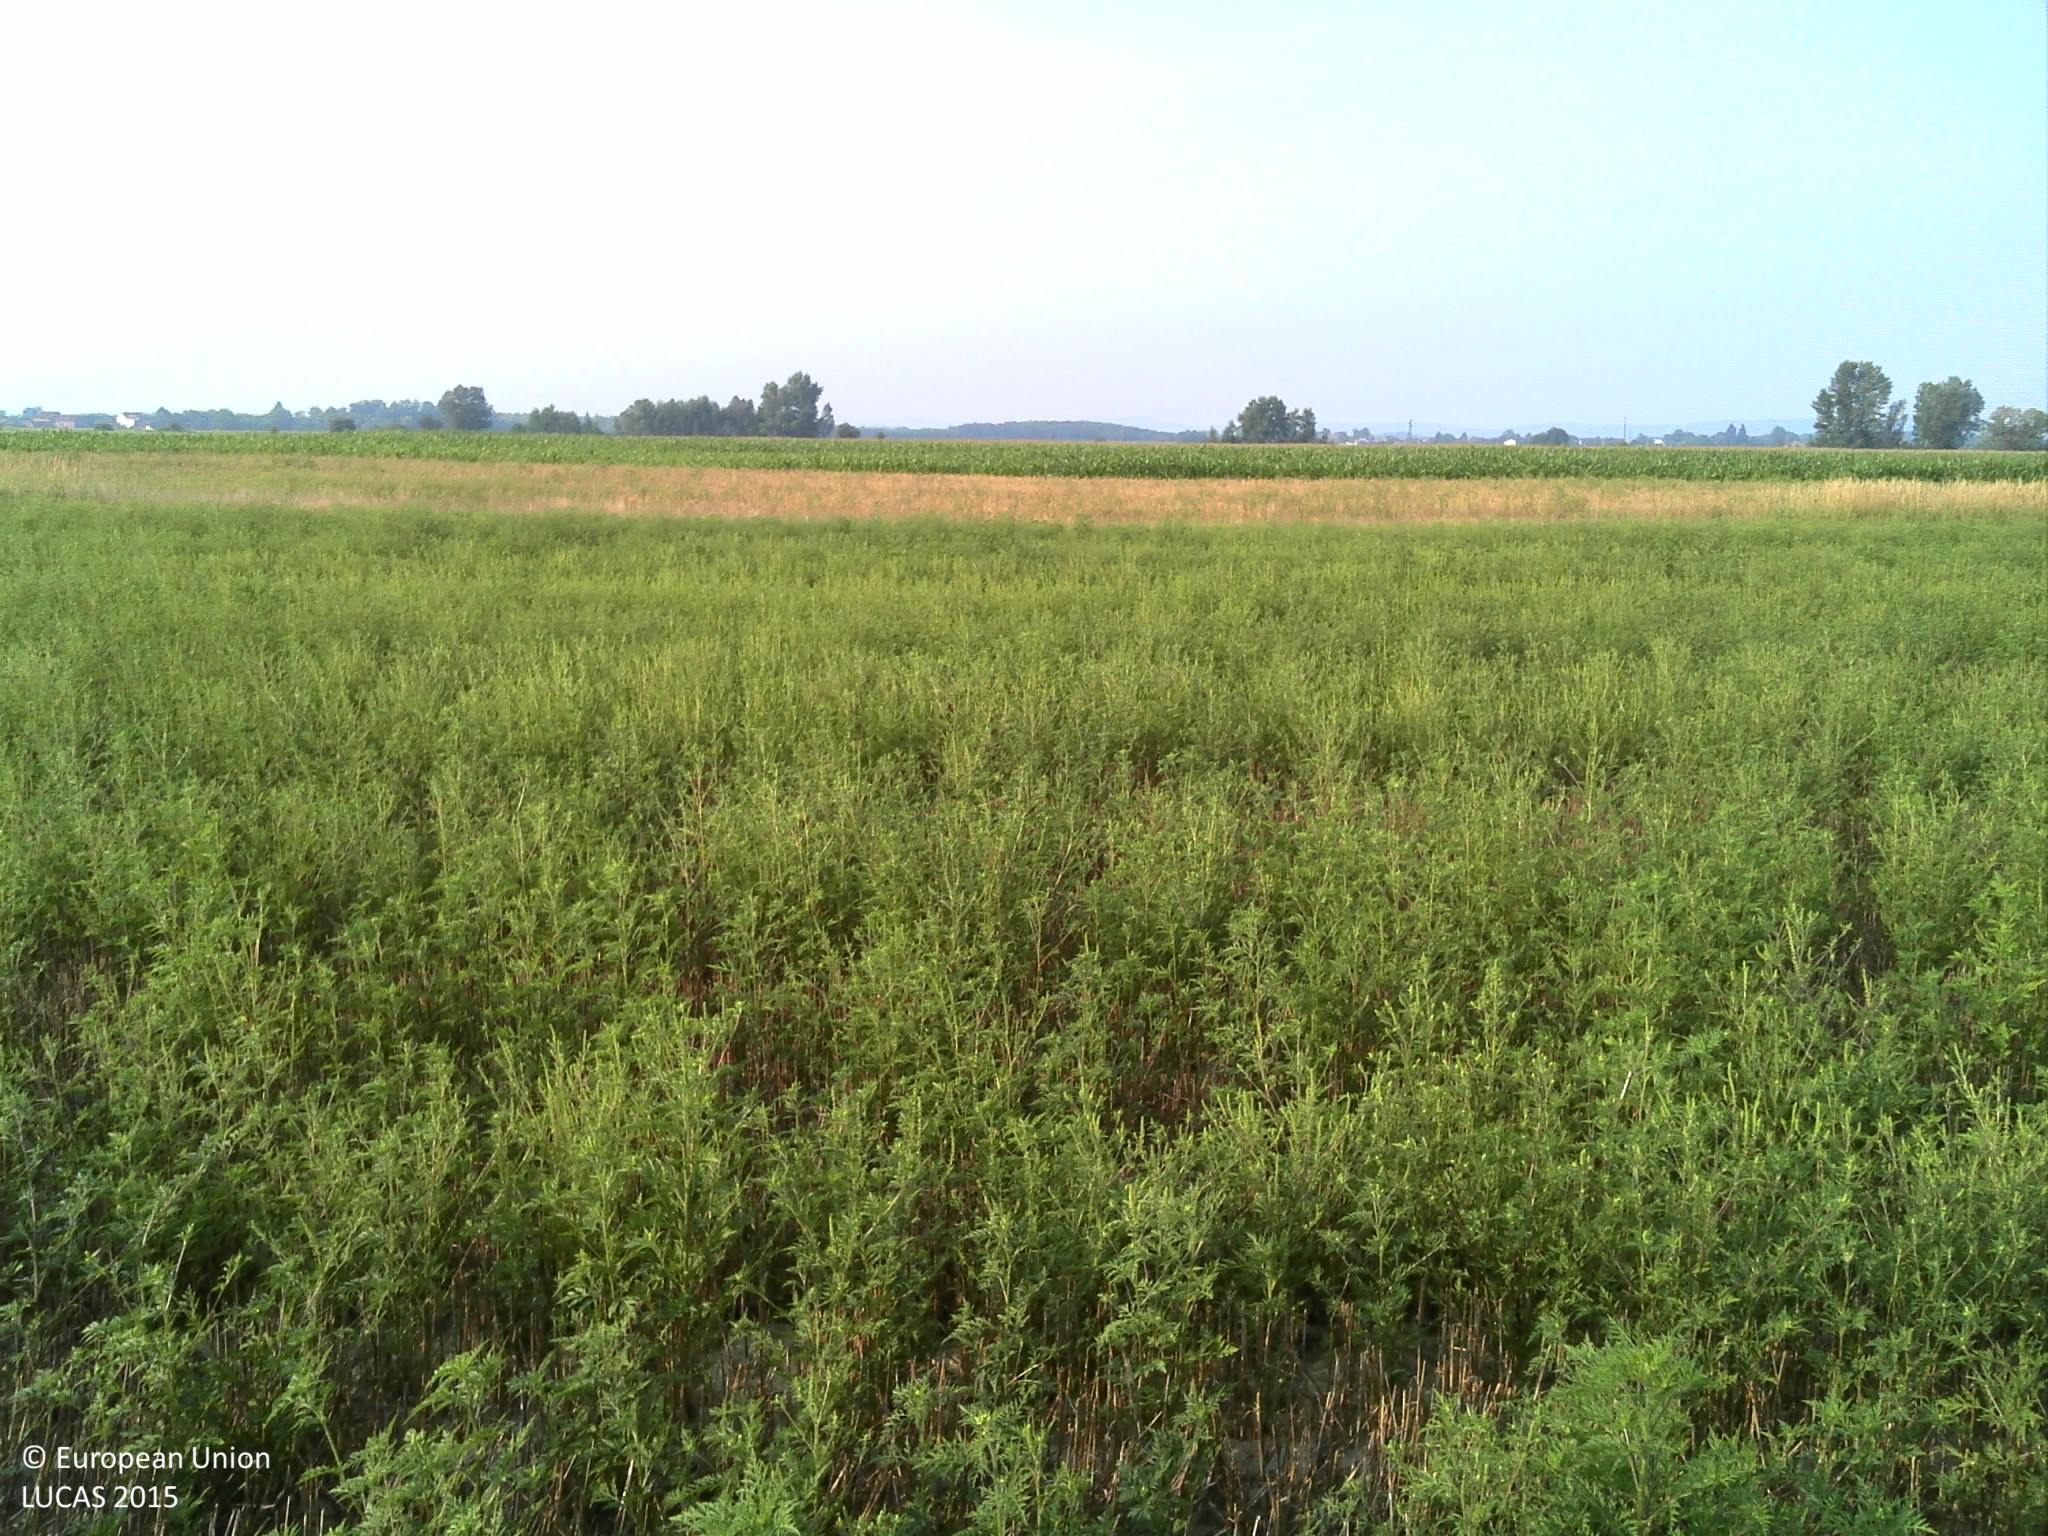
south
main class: Cropland
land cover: Common wheat
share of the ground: 10 - 25 %
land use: Agriculture (excluding fallow land and kitchen gardens)
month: August
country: HR
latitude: 45.9806
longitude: 17.2176
